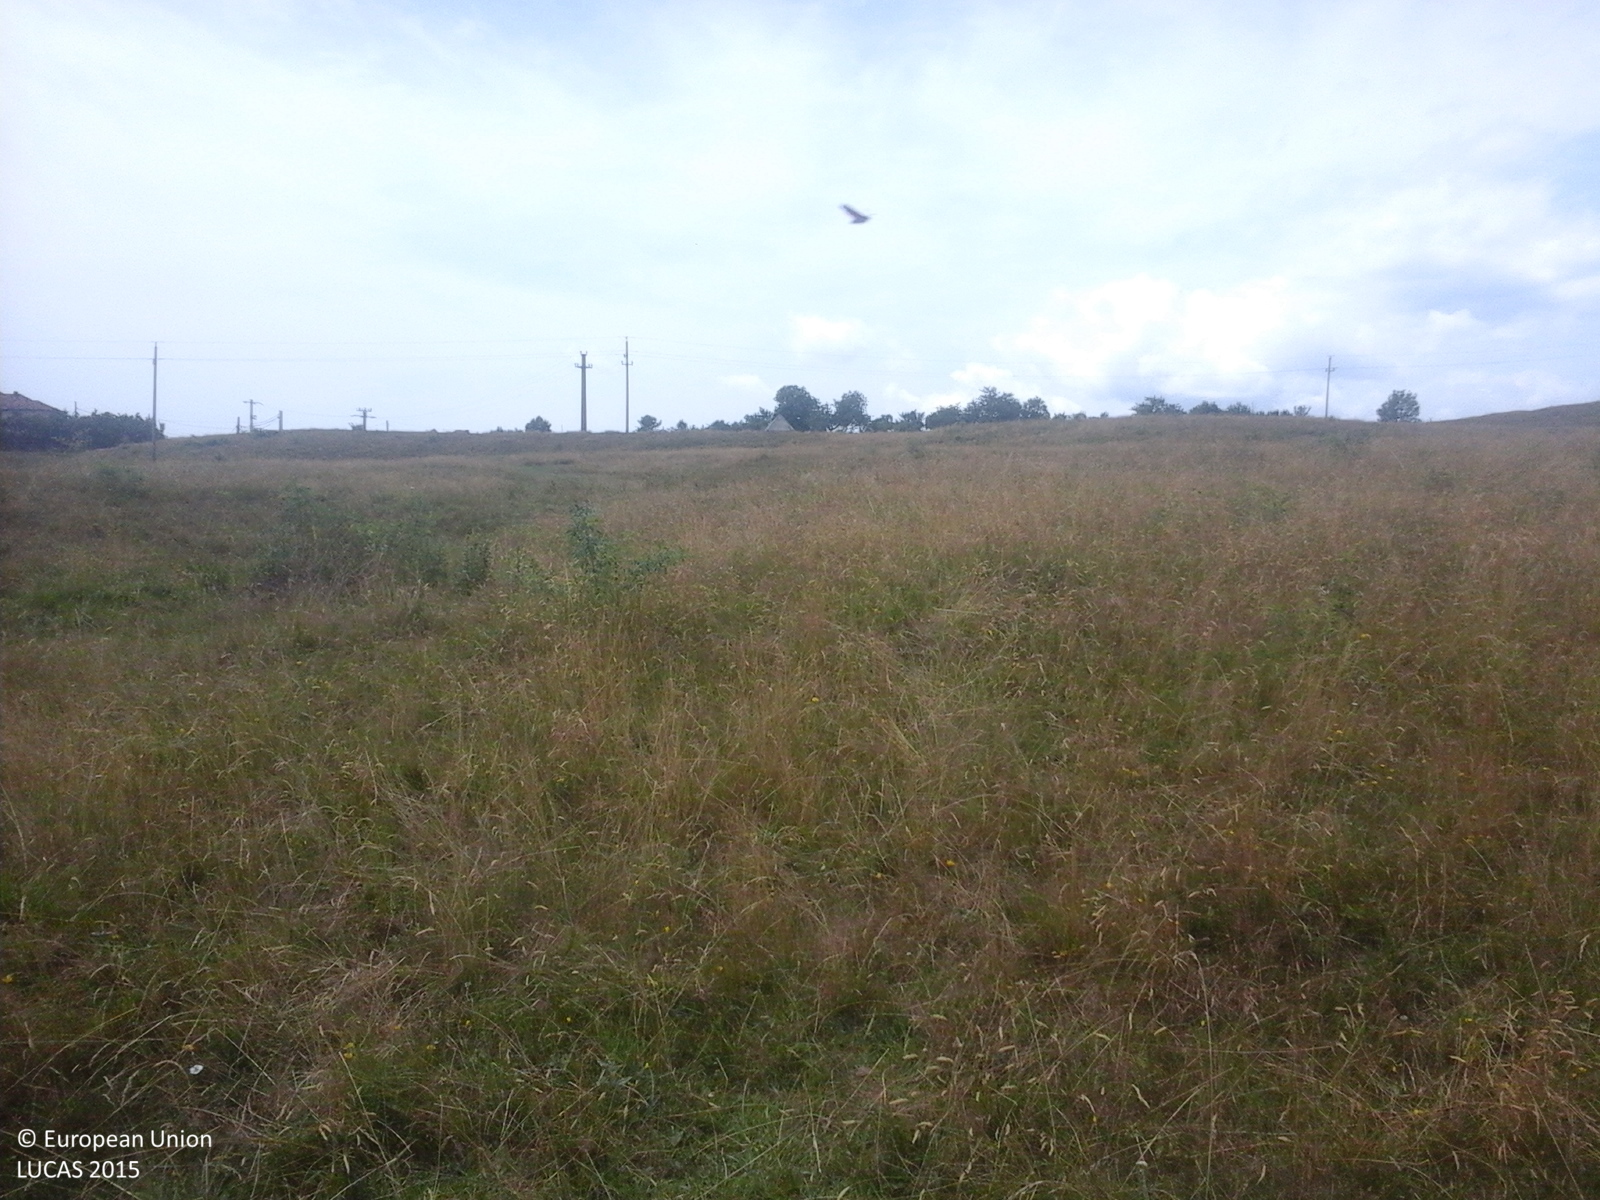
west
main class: Grassland
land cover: Grassland without tree/shrub cover
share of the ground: > 75 %
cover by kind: herbaceous plants 100 %
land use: Agriculture (excluding fallow land and kitchen gardens)
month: July
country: RO
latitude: 45.2171
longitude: 24.5829
